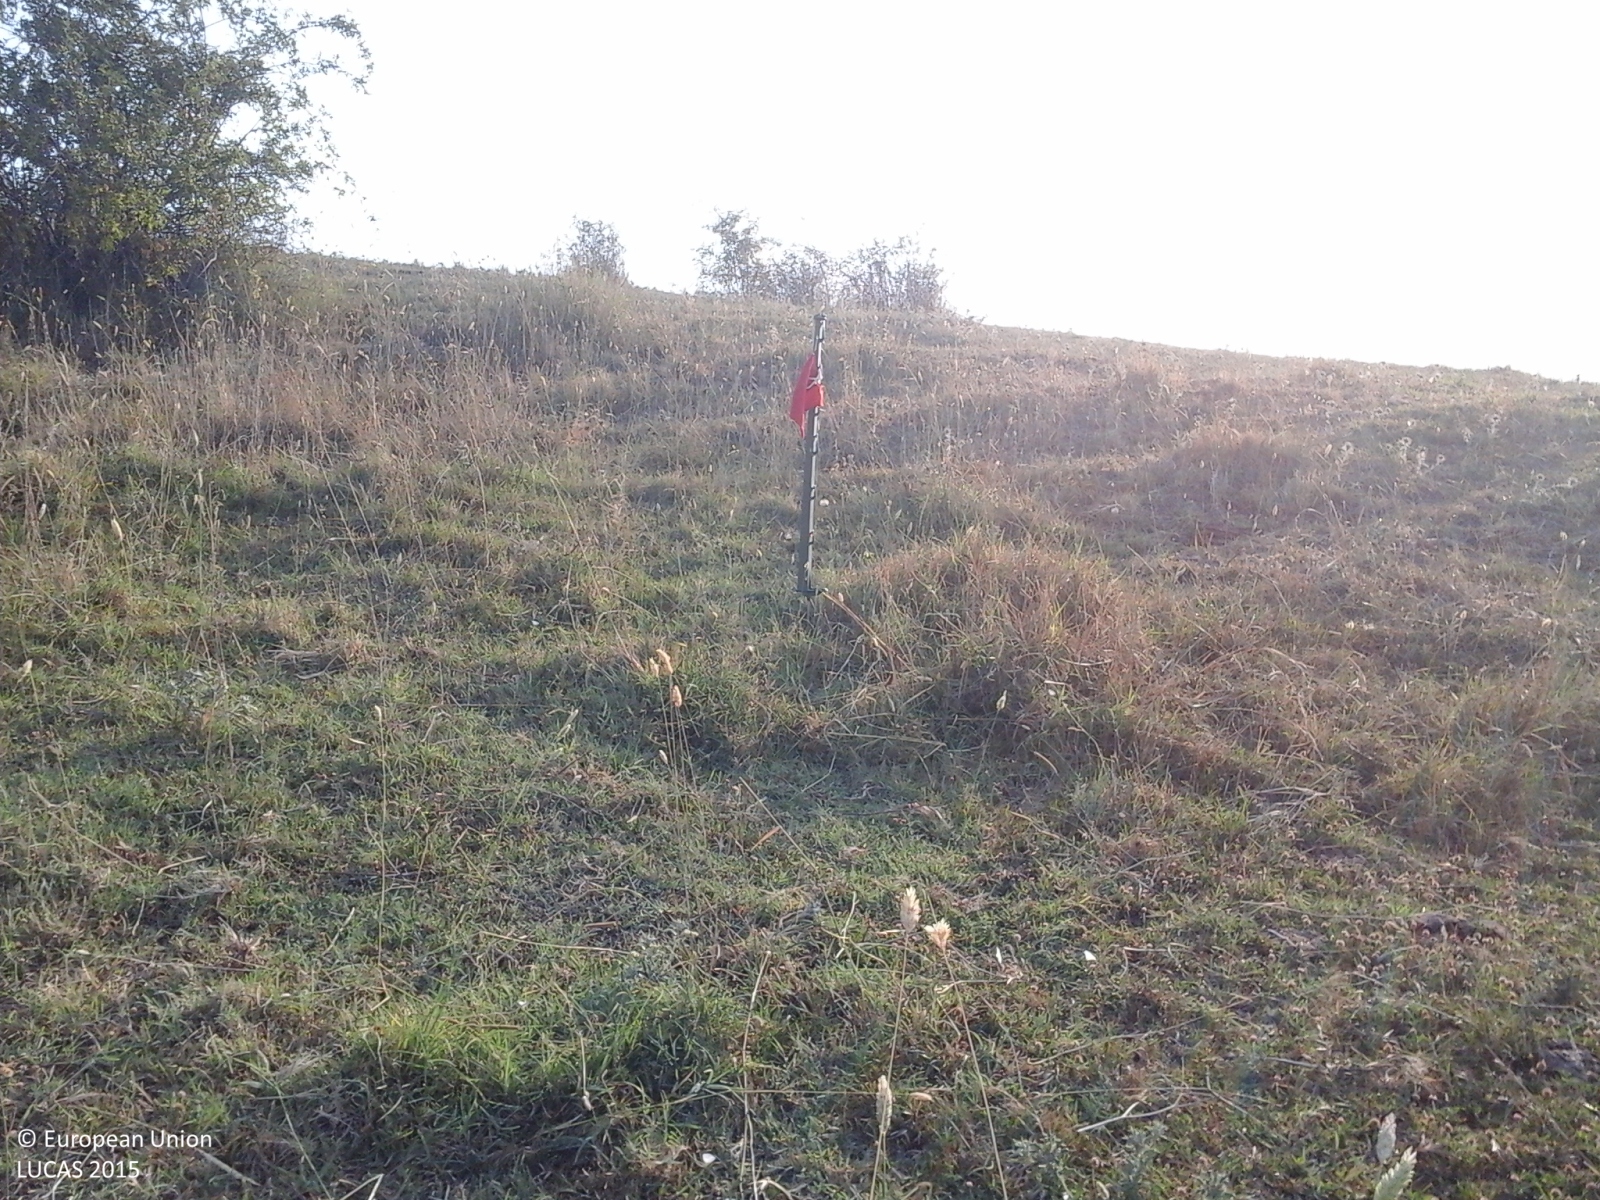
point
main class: Grassland
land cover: Grassland with sparse tree/shrub cover
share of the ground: > 75 %
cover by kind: herbaceous plants 95 %, broadleaved forest trees 5 %
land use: Agriculture (excluding fallow land and kitchen gardens)
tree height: < 5 m
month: July
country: IT
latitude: 44.0166
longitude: 12.3771
